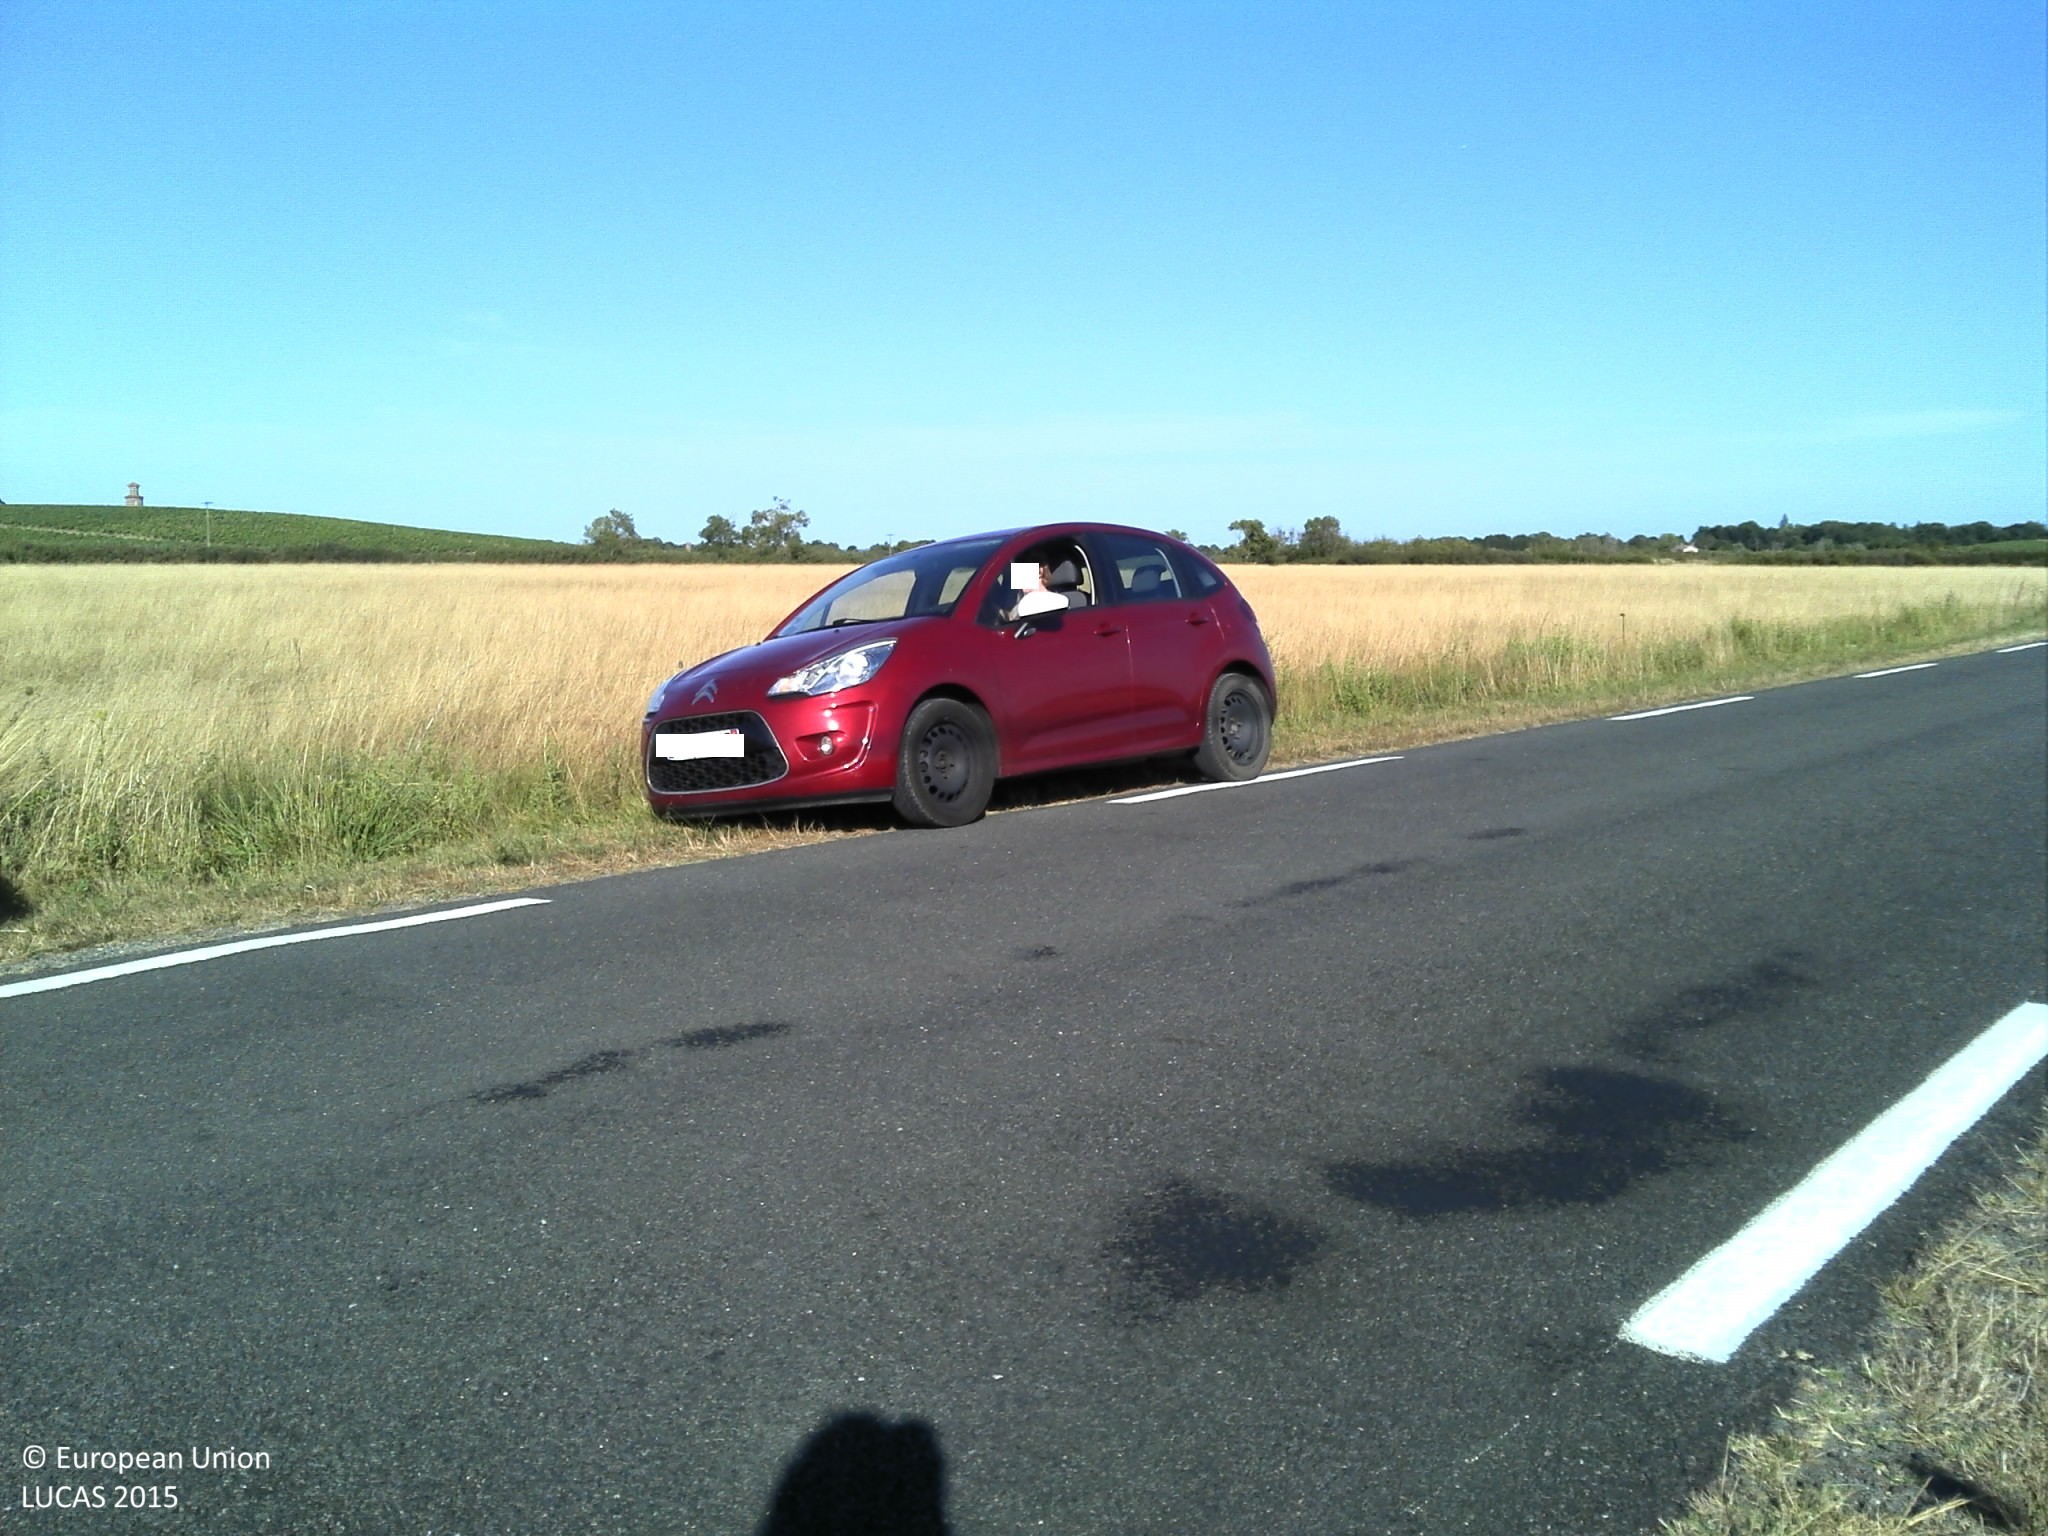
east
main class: Grassland
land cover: Grassland without tree/shrub cover
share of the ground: > 75 %
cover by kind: herbaceous plants 100 %
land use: Agriculture (excluding fallow land and kitchen gardens)
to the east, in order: Grassland without tree/shrub cover; Fences; Grassland without tree/shrub cover; Grass margins; Ditches and canals; Tracks
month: July
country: FR
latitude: 45.3120
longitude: -0.8017
